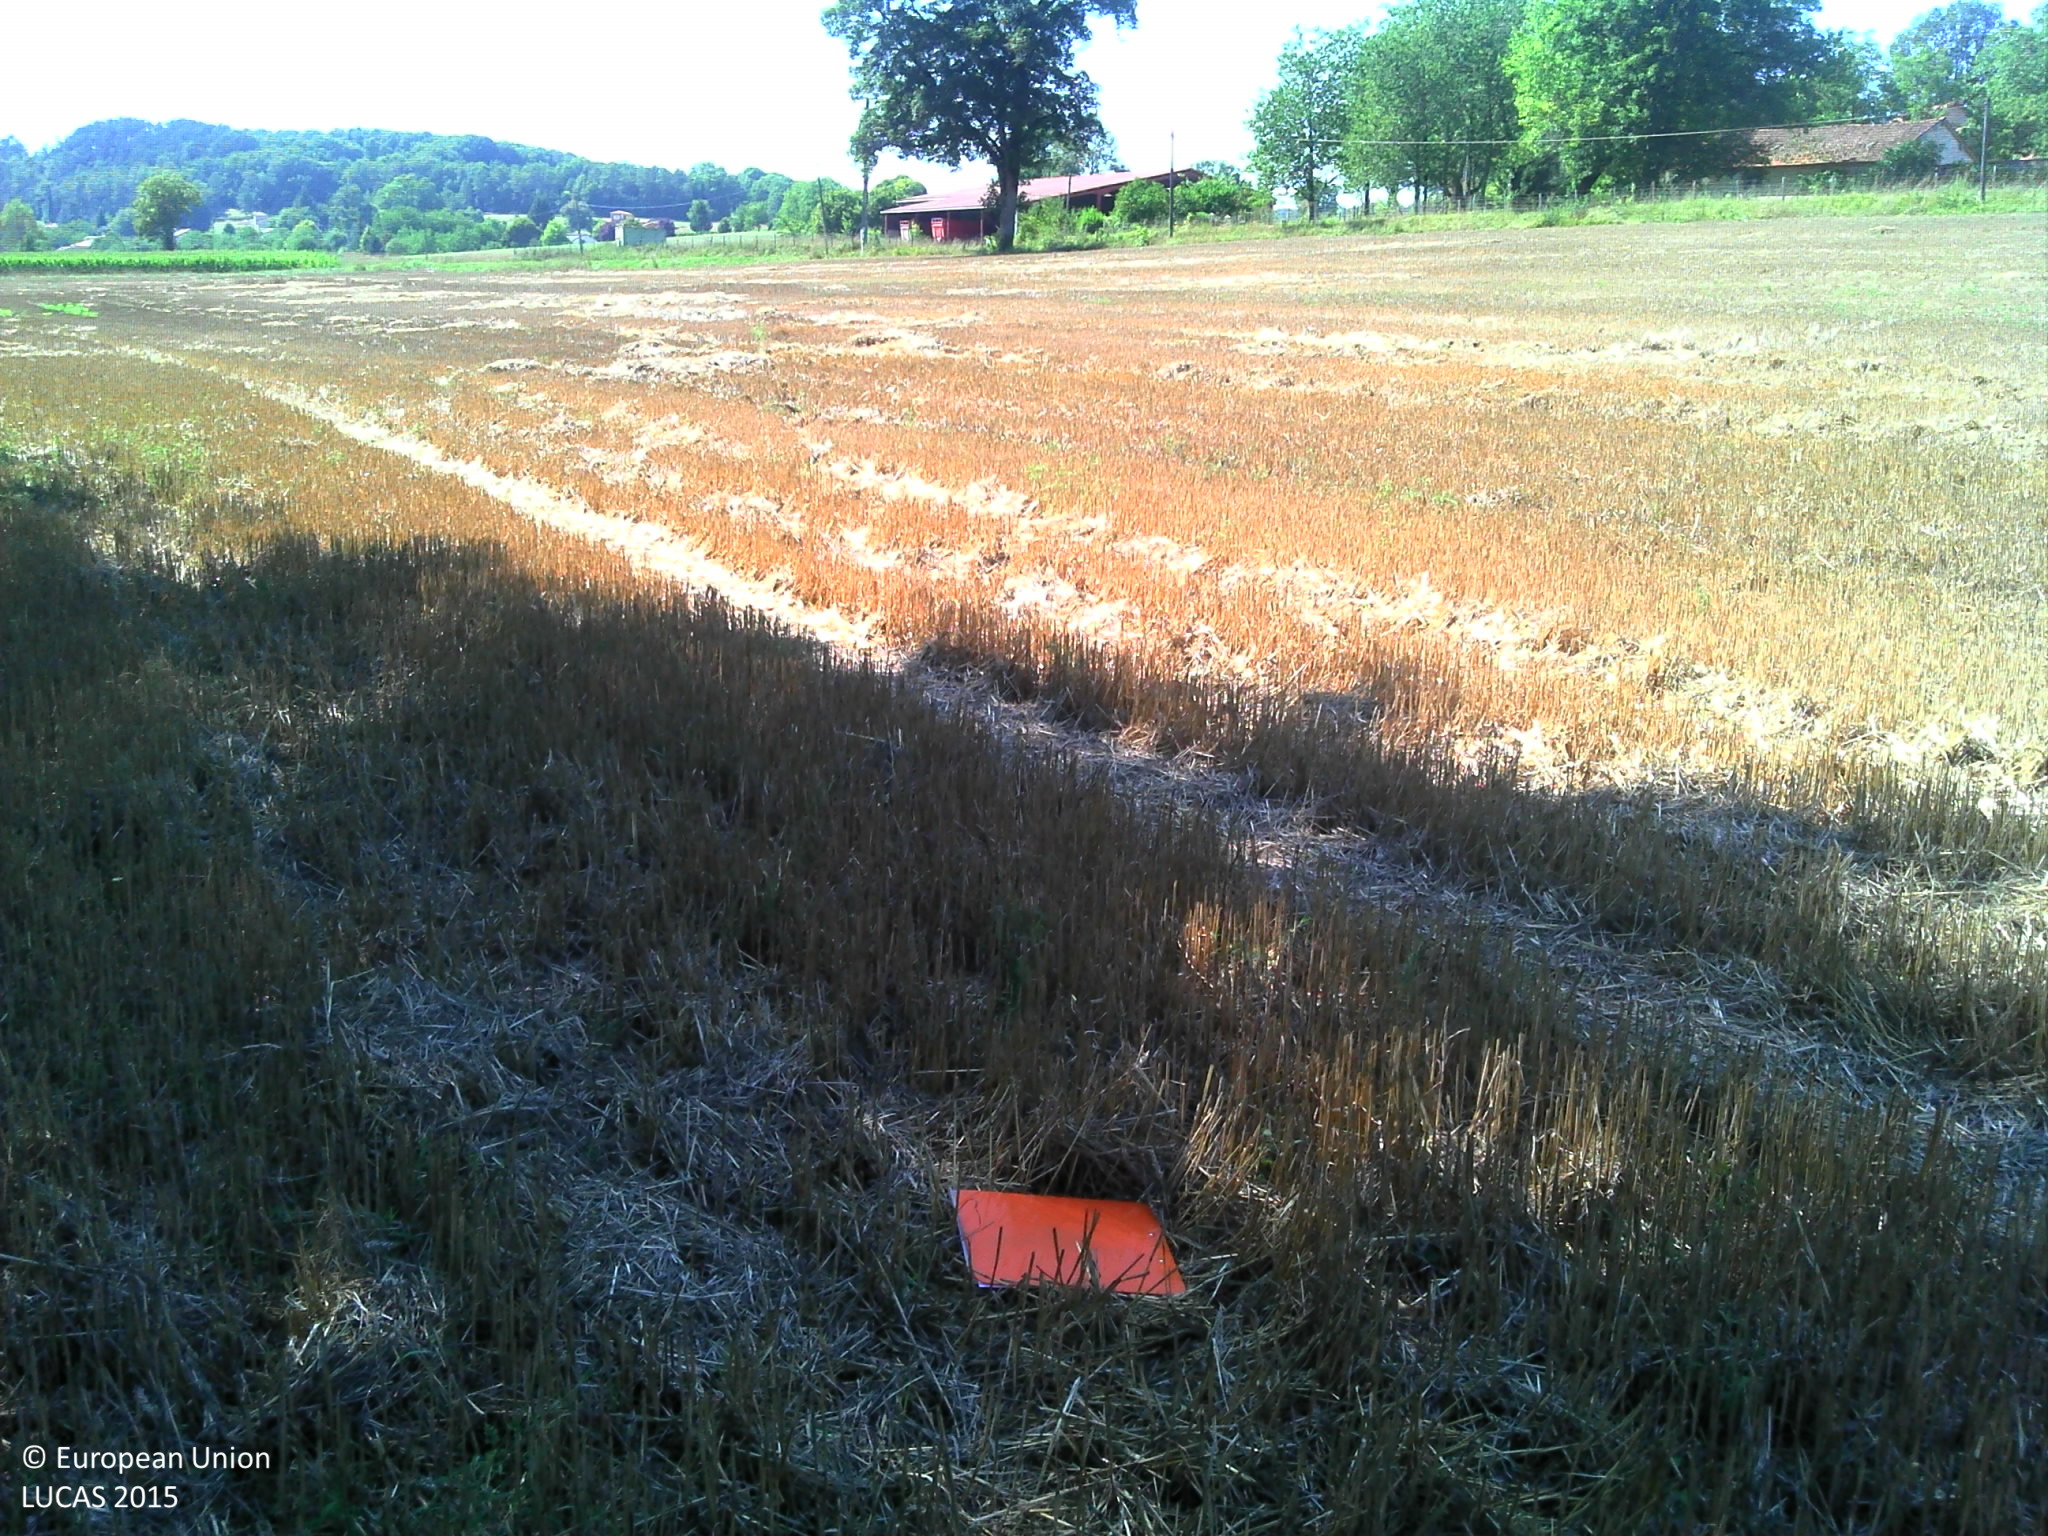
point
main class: Cropland
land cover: Common wheat
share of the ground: 10 - 25 %
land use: Agriculture (excluding fallow land and kitchen gardens)
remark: Harvested field
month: August
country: FR
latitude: 45.2988
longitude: 0.7700
